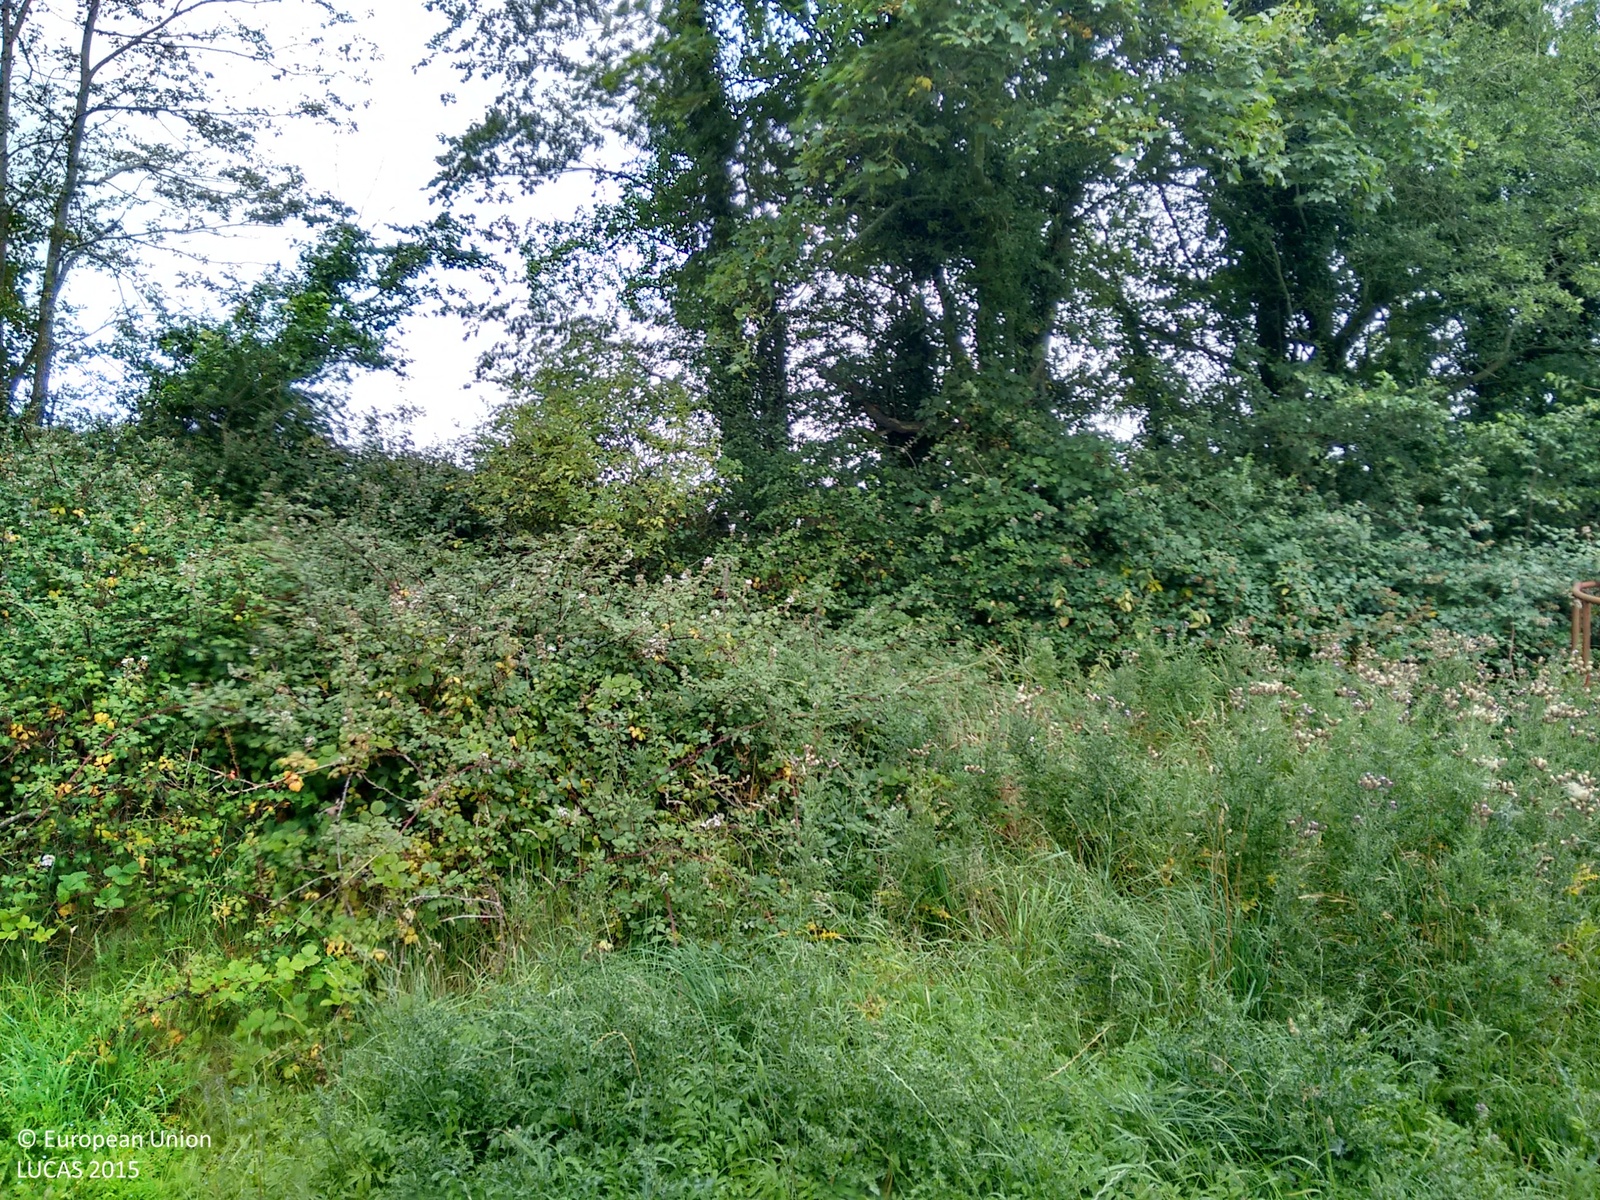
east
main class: Grassland
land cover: Grassland without tree/shrub cover
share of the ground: > 75 %
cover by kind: herbaceous plants 100 %
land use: Agriculture (excluding fallow land and kitchen gardens)
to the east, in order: Grassland without tree/shrub cover; Managed hedges; Grassland without tree/shrub cover; Managed hedges; Grassland without tree/shrub cover; Managed hedges; Grassland without tree/shrub cover
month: August
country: IE
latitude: 52.8729
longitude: -7.3431
